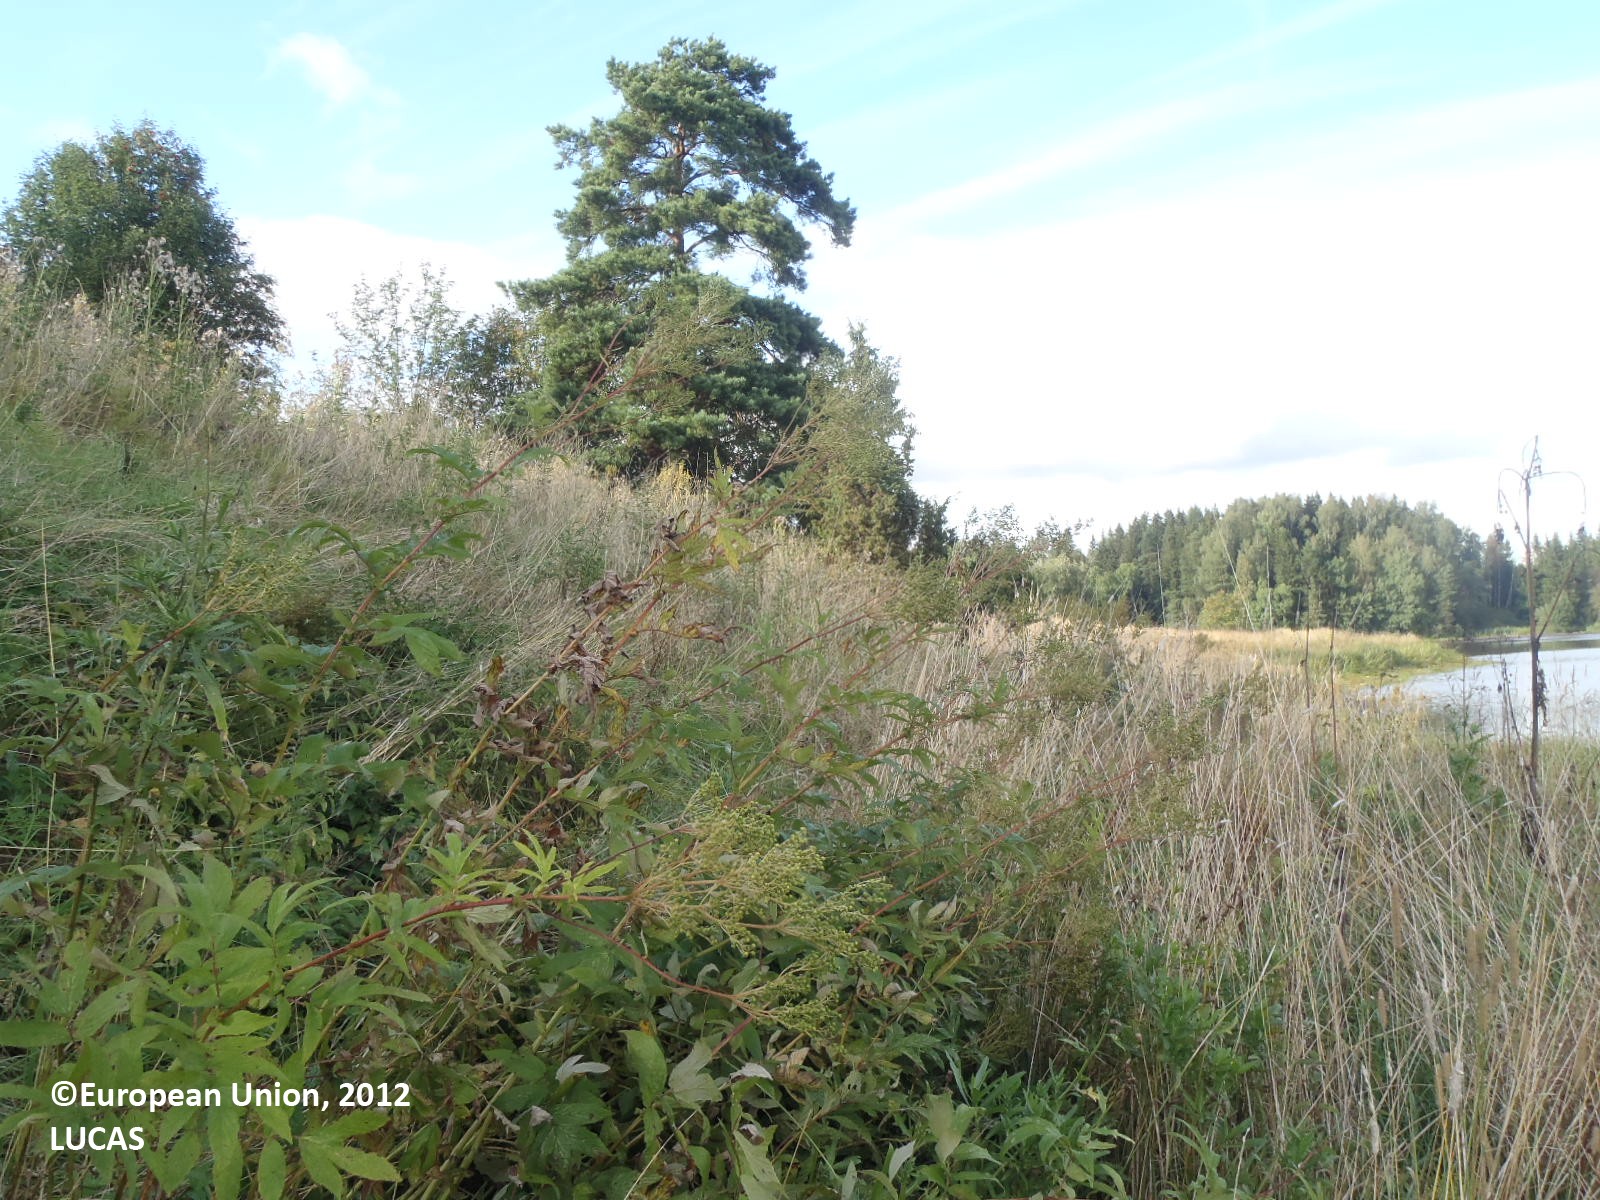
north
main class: Grassland
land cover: Grassland without tree/shrub cover
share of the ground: > 75 %
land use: Agriculture (excluding fallow land and kitchen gardens)
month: August
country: FI
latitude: 60.5352
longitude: 22.7032
